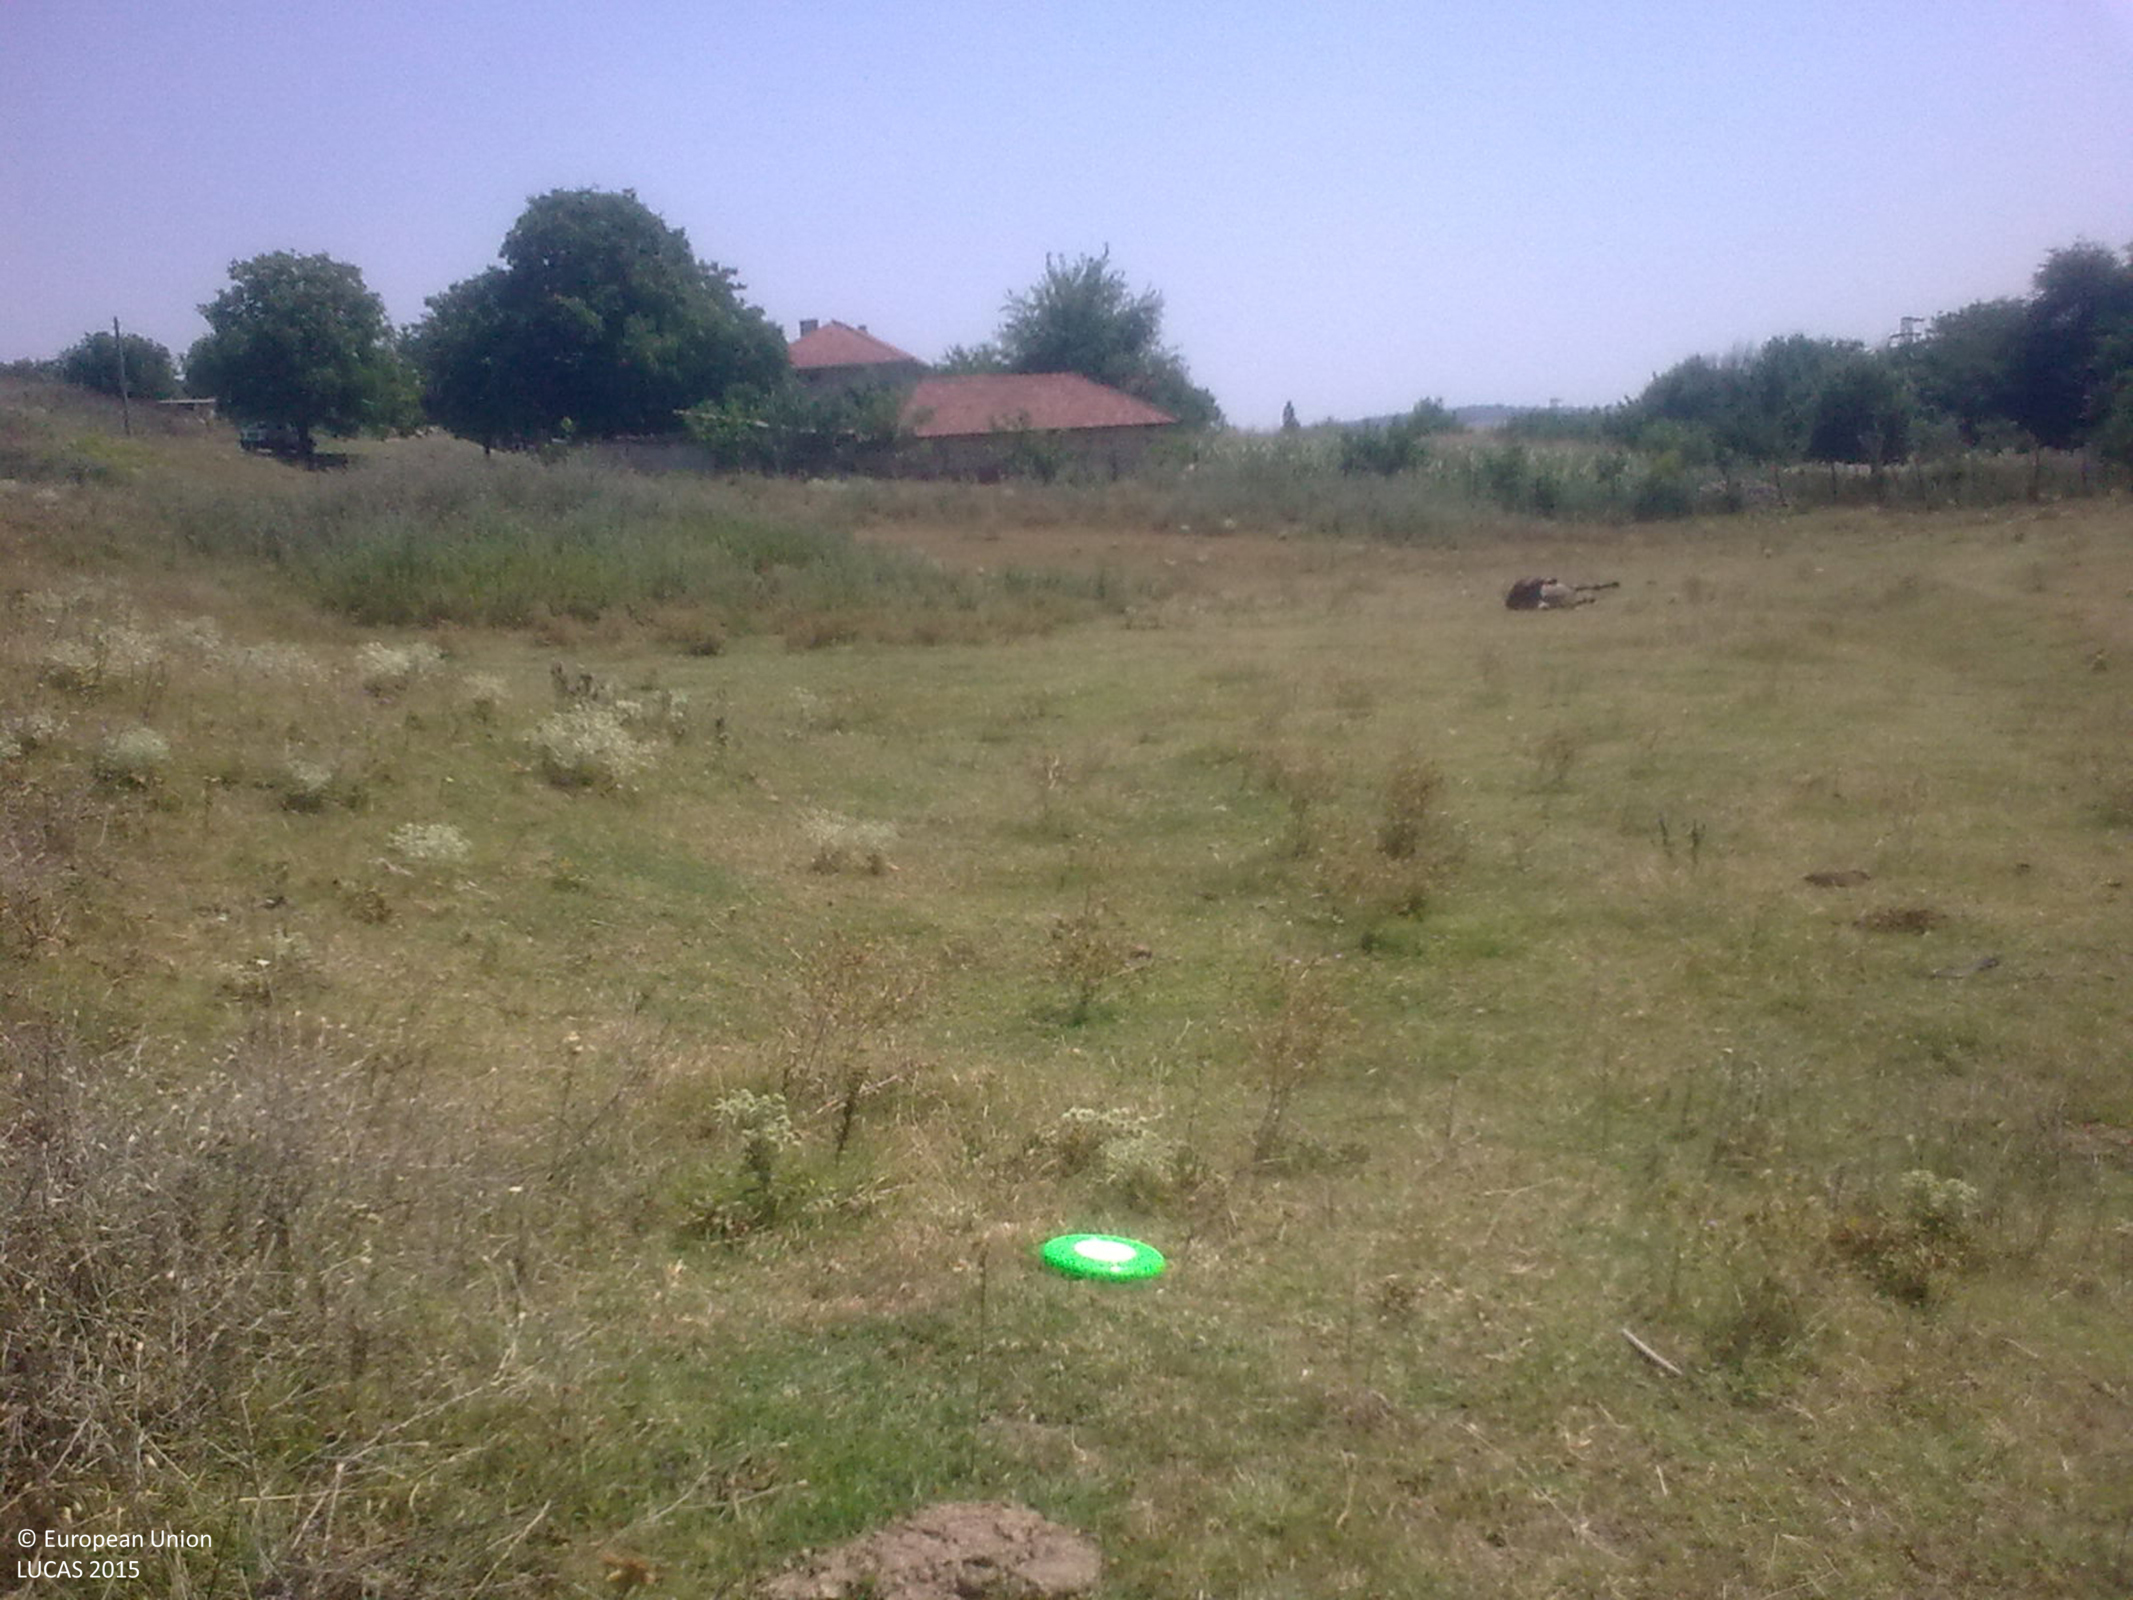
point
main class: Grassland
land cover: Grassland without tree/shrub cover
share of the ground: > 75 %
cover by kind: herbaceous plants 100 %
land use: Agriculture (excluding fallow land and kitchen gardens)
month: July
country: BG
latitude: 43.8630
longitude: 26.1635
